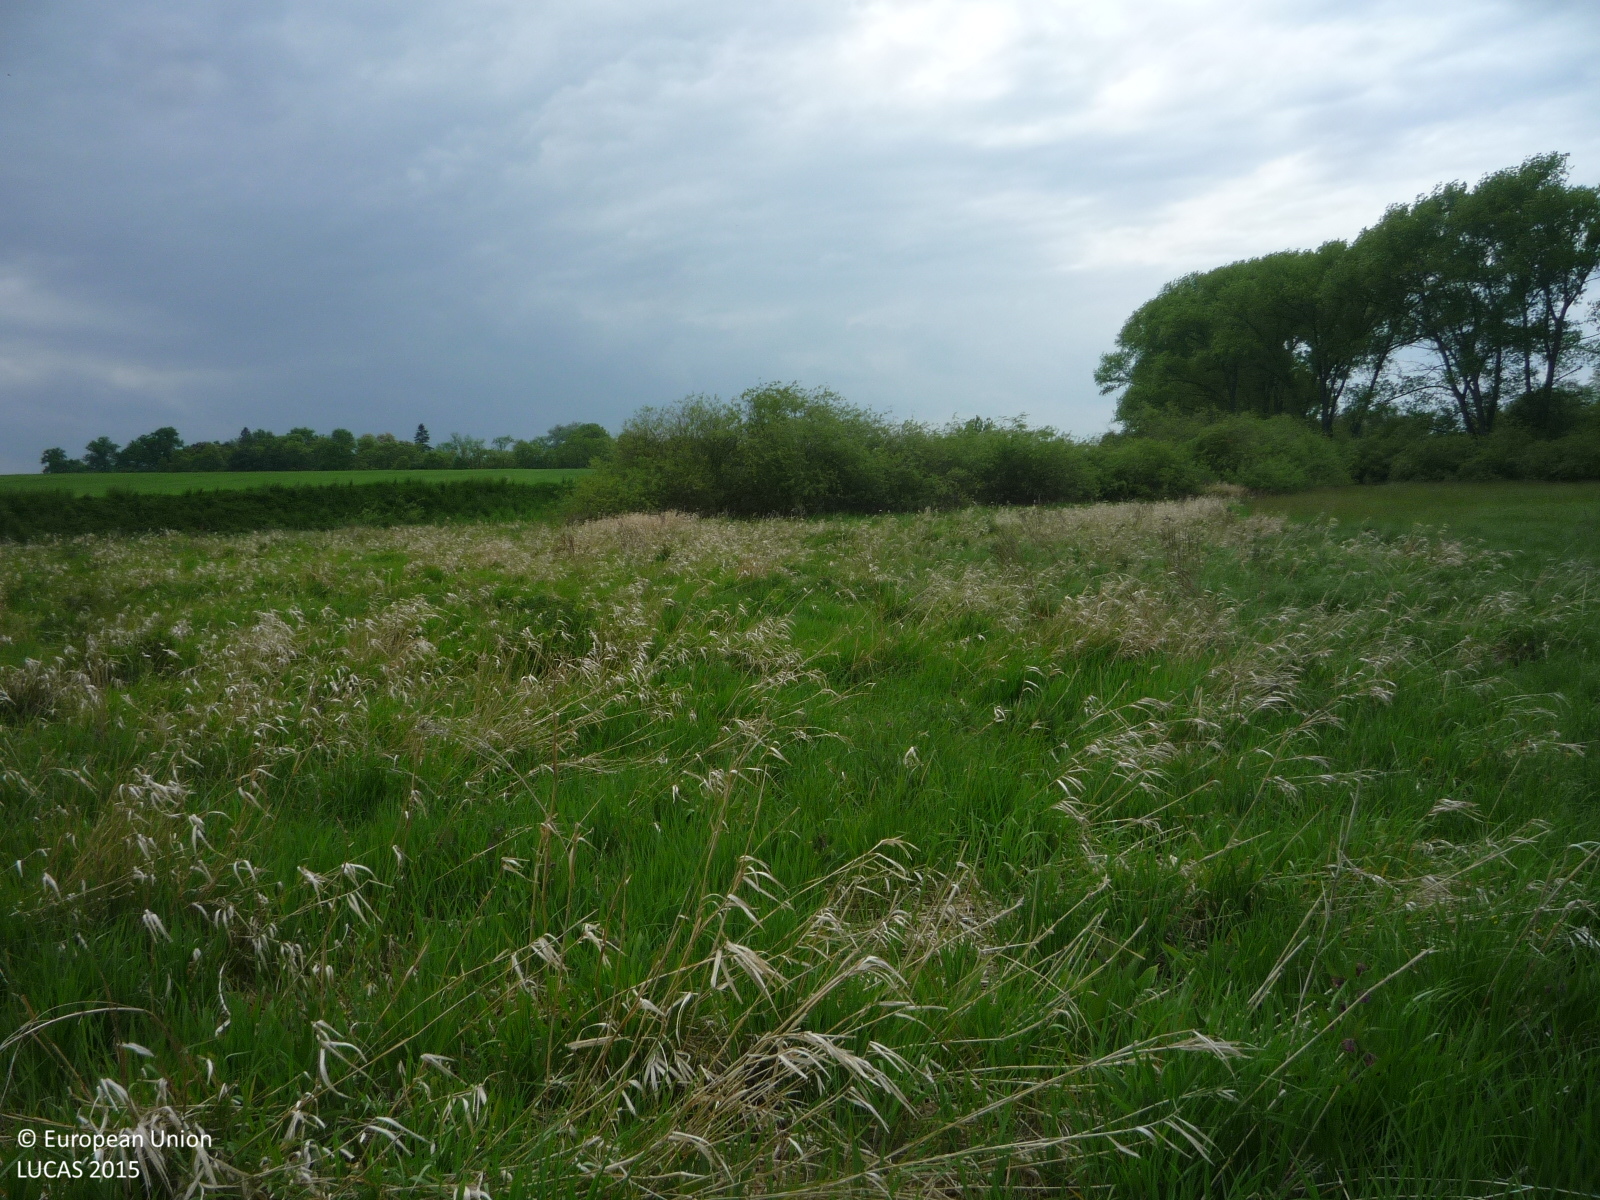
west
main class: Grassland
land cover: Grassland without tree/shrub cover
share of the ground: > 75 %
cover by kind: herbaceous plants 100 %
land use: Semi-natural and natural areas not in use
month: May
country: CZ
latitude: 50.0197
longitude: 14.5937
